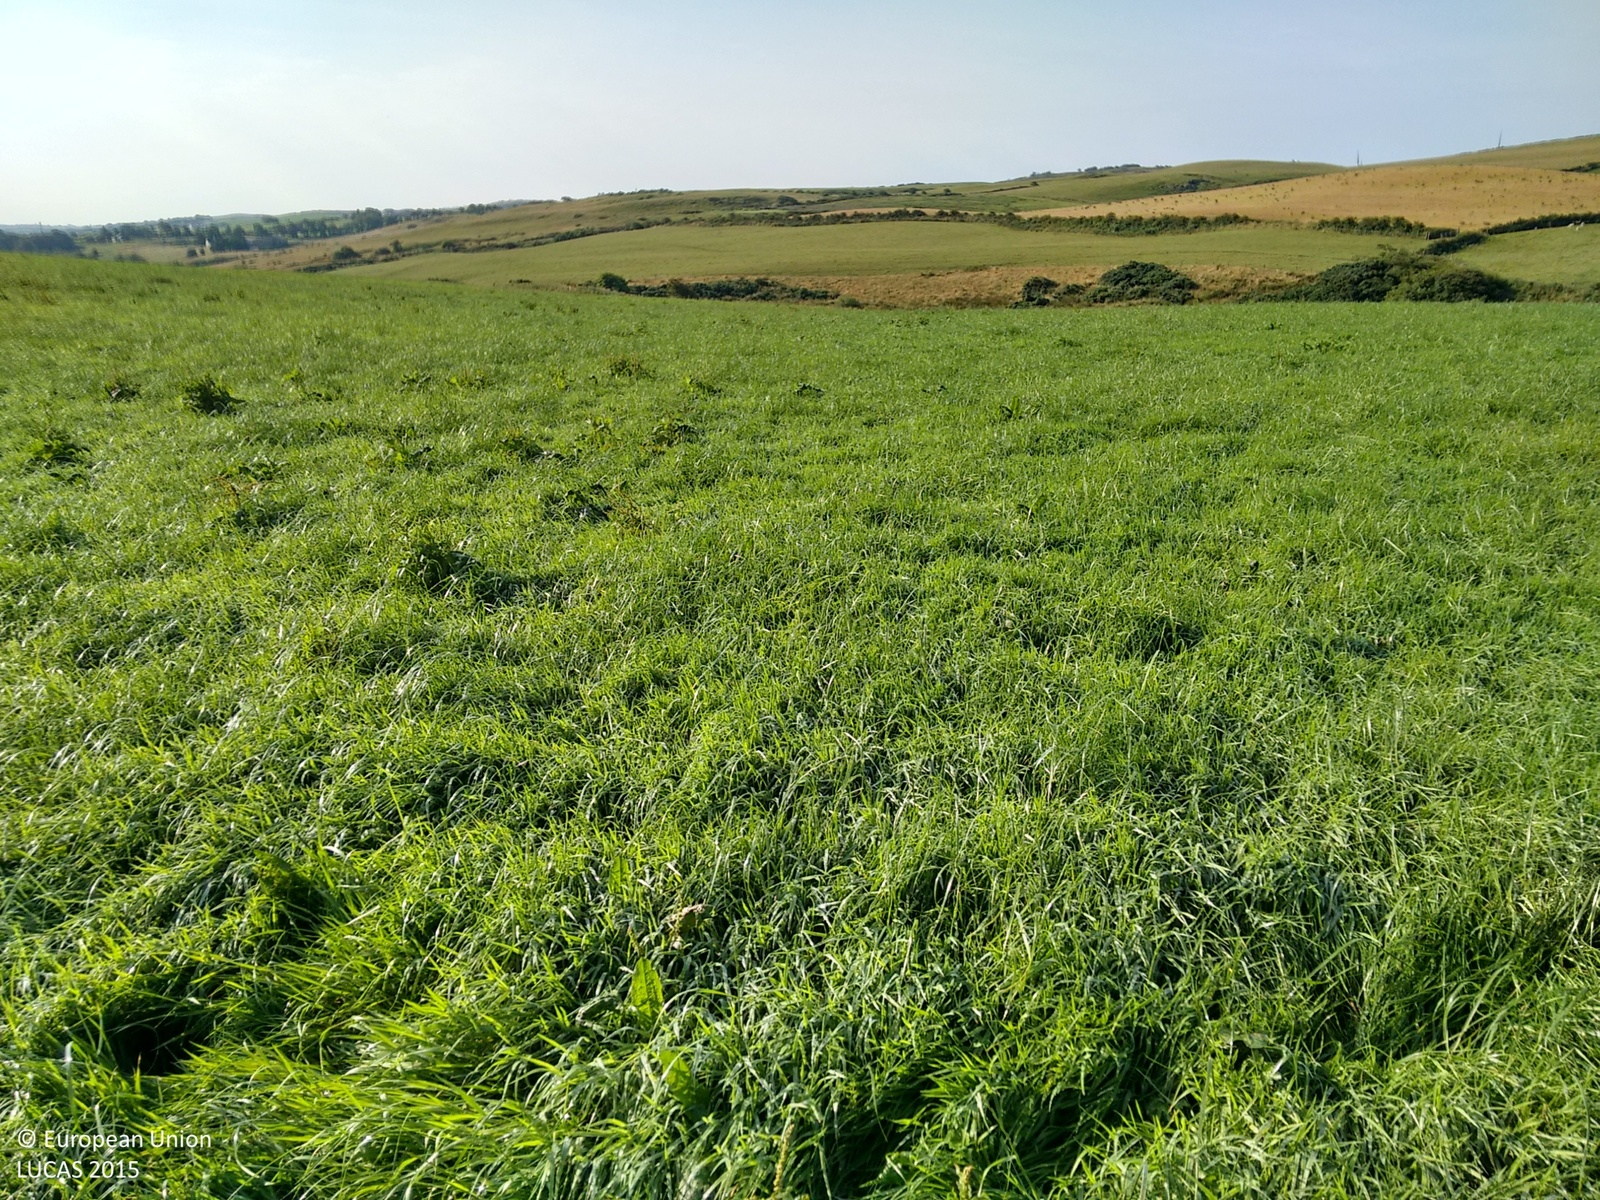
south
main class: Grassland
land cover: Grassland without tree/shrub cover
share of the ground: > 75 %
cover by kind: herbaceous plants 100 %
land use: Agriculture (excluding fallow land and kitchen gardens)
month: August
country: GB
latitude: 54.9052
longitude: -5.0723
